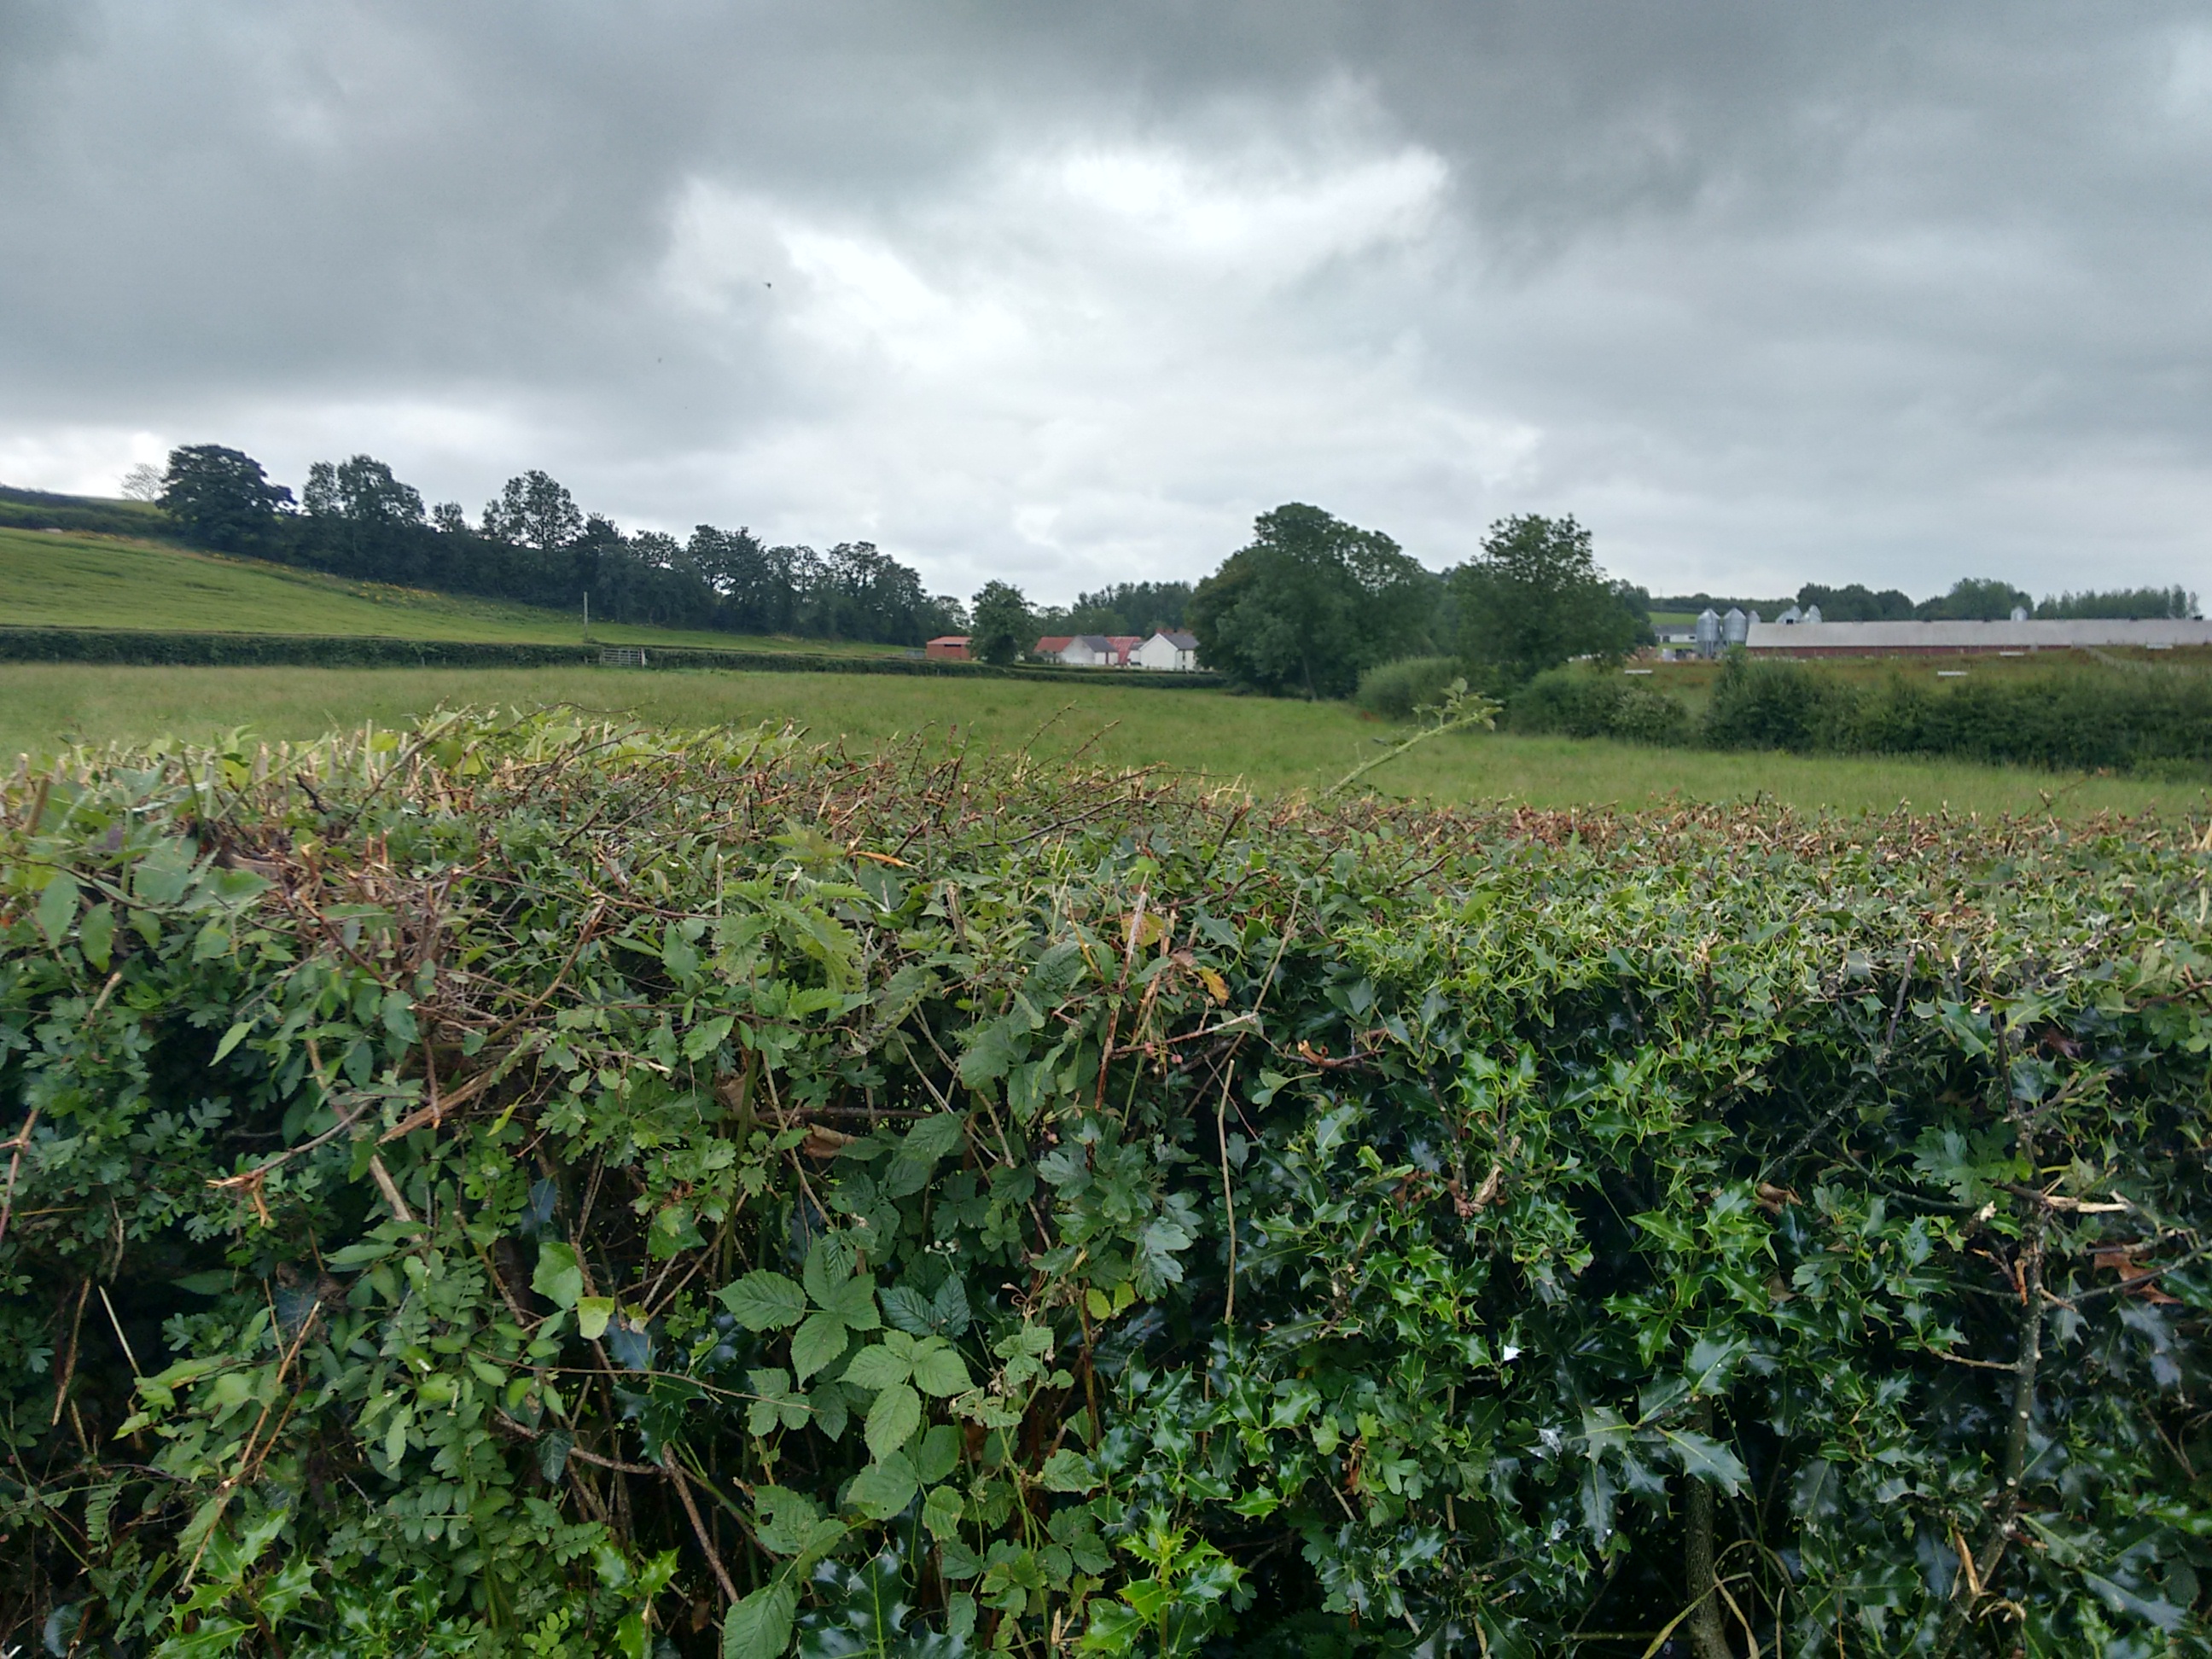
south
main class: Grassland
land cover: Grassland without tree/shrub cover
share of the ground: > 75 %
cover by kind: herbaceous plants 100 %
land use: Agriculture (excluding fallow land and kitchen gardens)
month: August
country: GB
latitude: 54.4026
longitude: -6.8175
